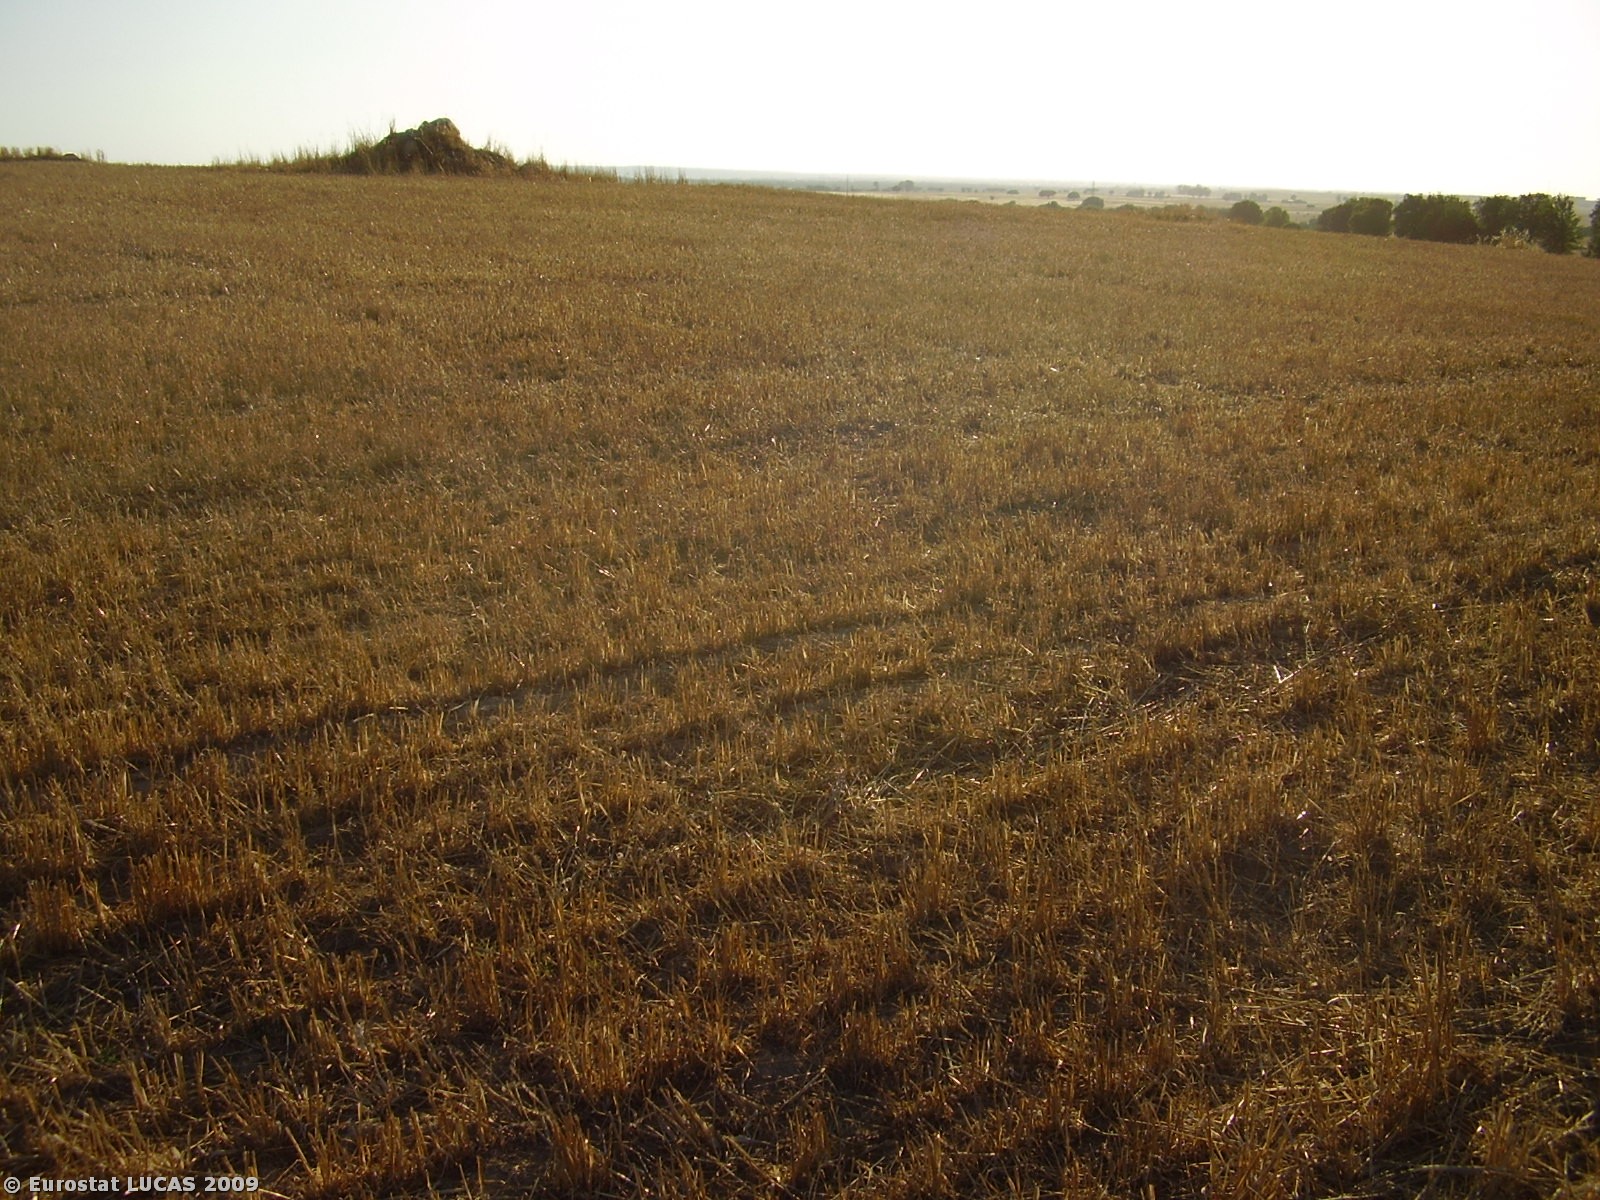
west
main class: Cropland
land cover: Oats
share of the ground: > 75 %
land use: Agriculture (excluding fallow land and kitchen gardens)
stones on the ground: 10 - 25 %
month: July
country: PT
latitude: 38.6192
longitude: -7.8293
